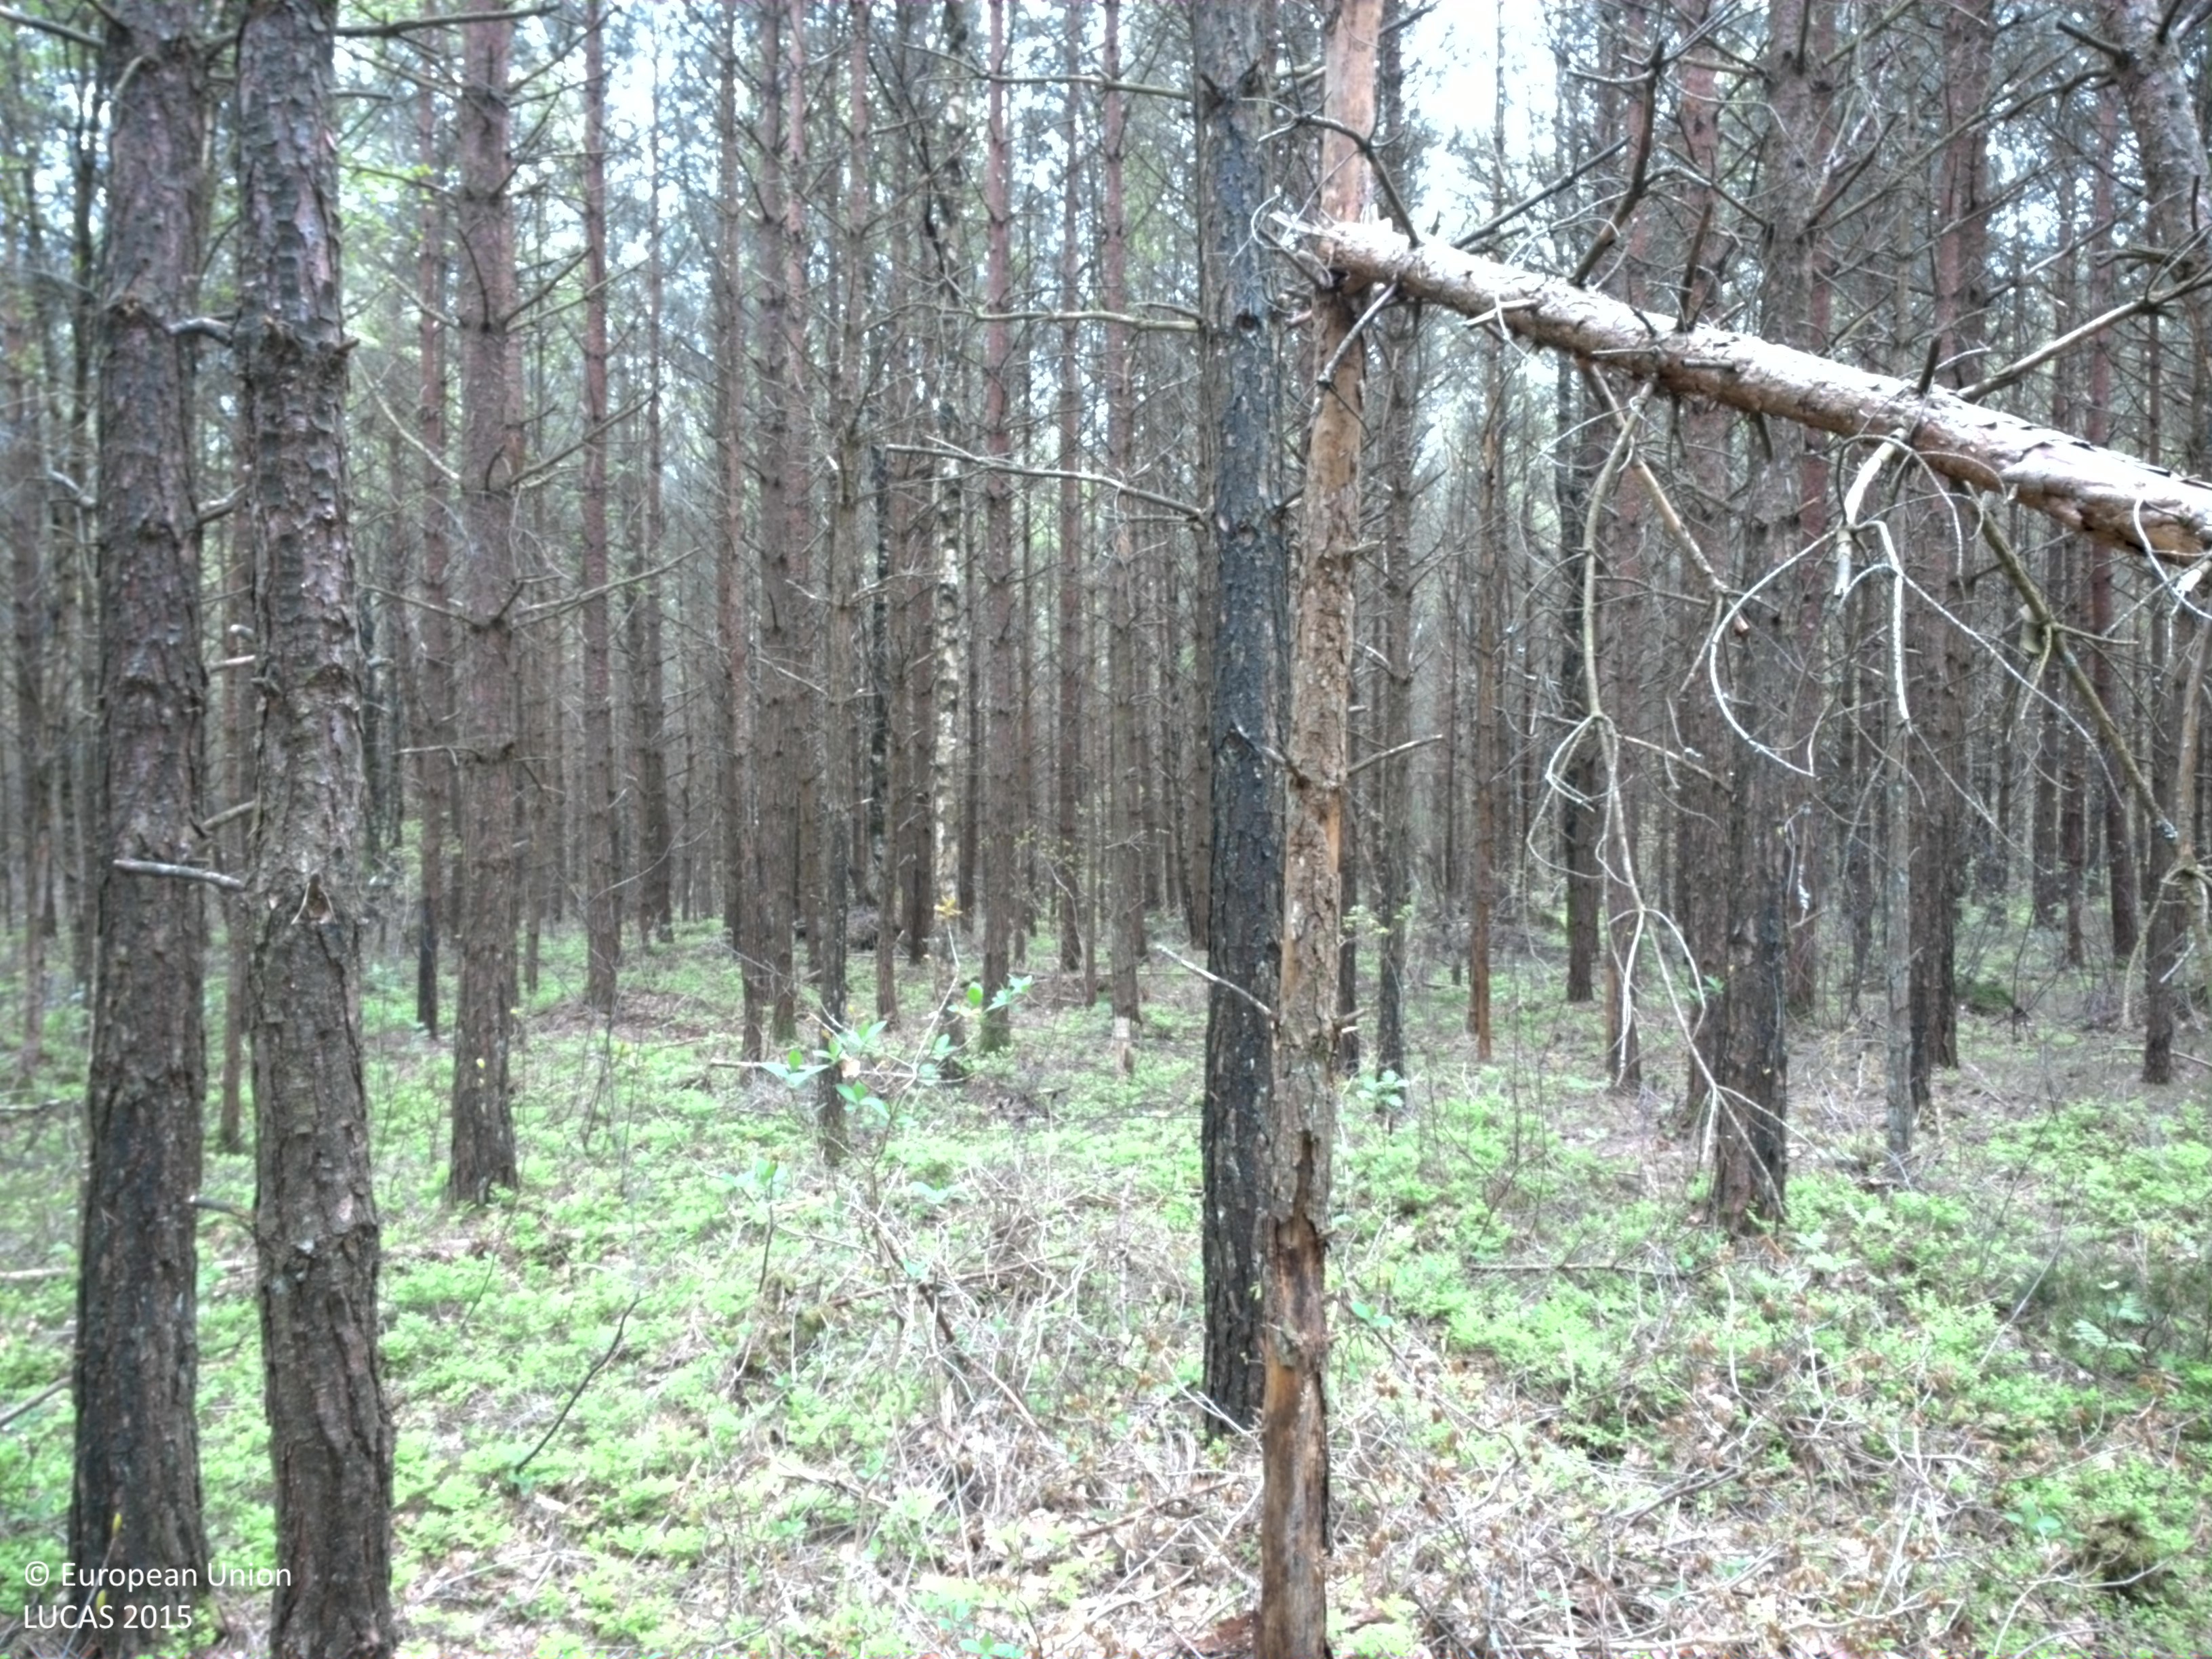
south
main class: Woodland
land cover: Pine dominated mixed woodland
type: boreal forest
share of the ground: > 75 %
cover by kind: coniferous forest trees 55 %, broadleaved forest trees 25 %, shrubs 15 %, herbaceous plants 5 %
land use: Forestry
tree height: > 5 m
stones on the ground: < 10 %
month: May
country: SE
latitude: 57.8093
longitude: 11.9657
